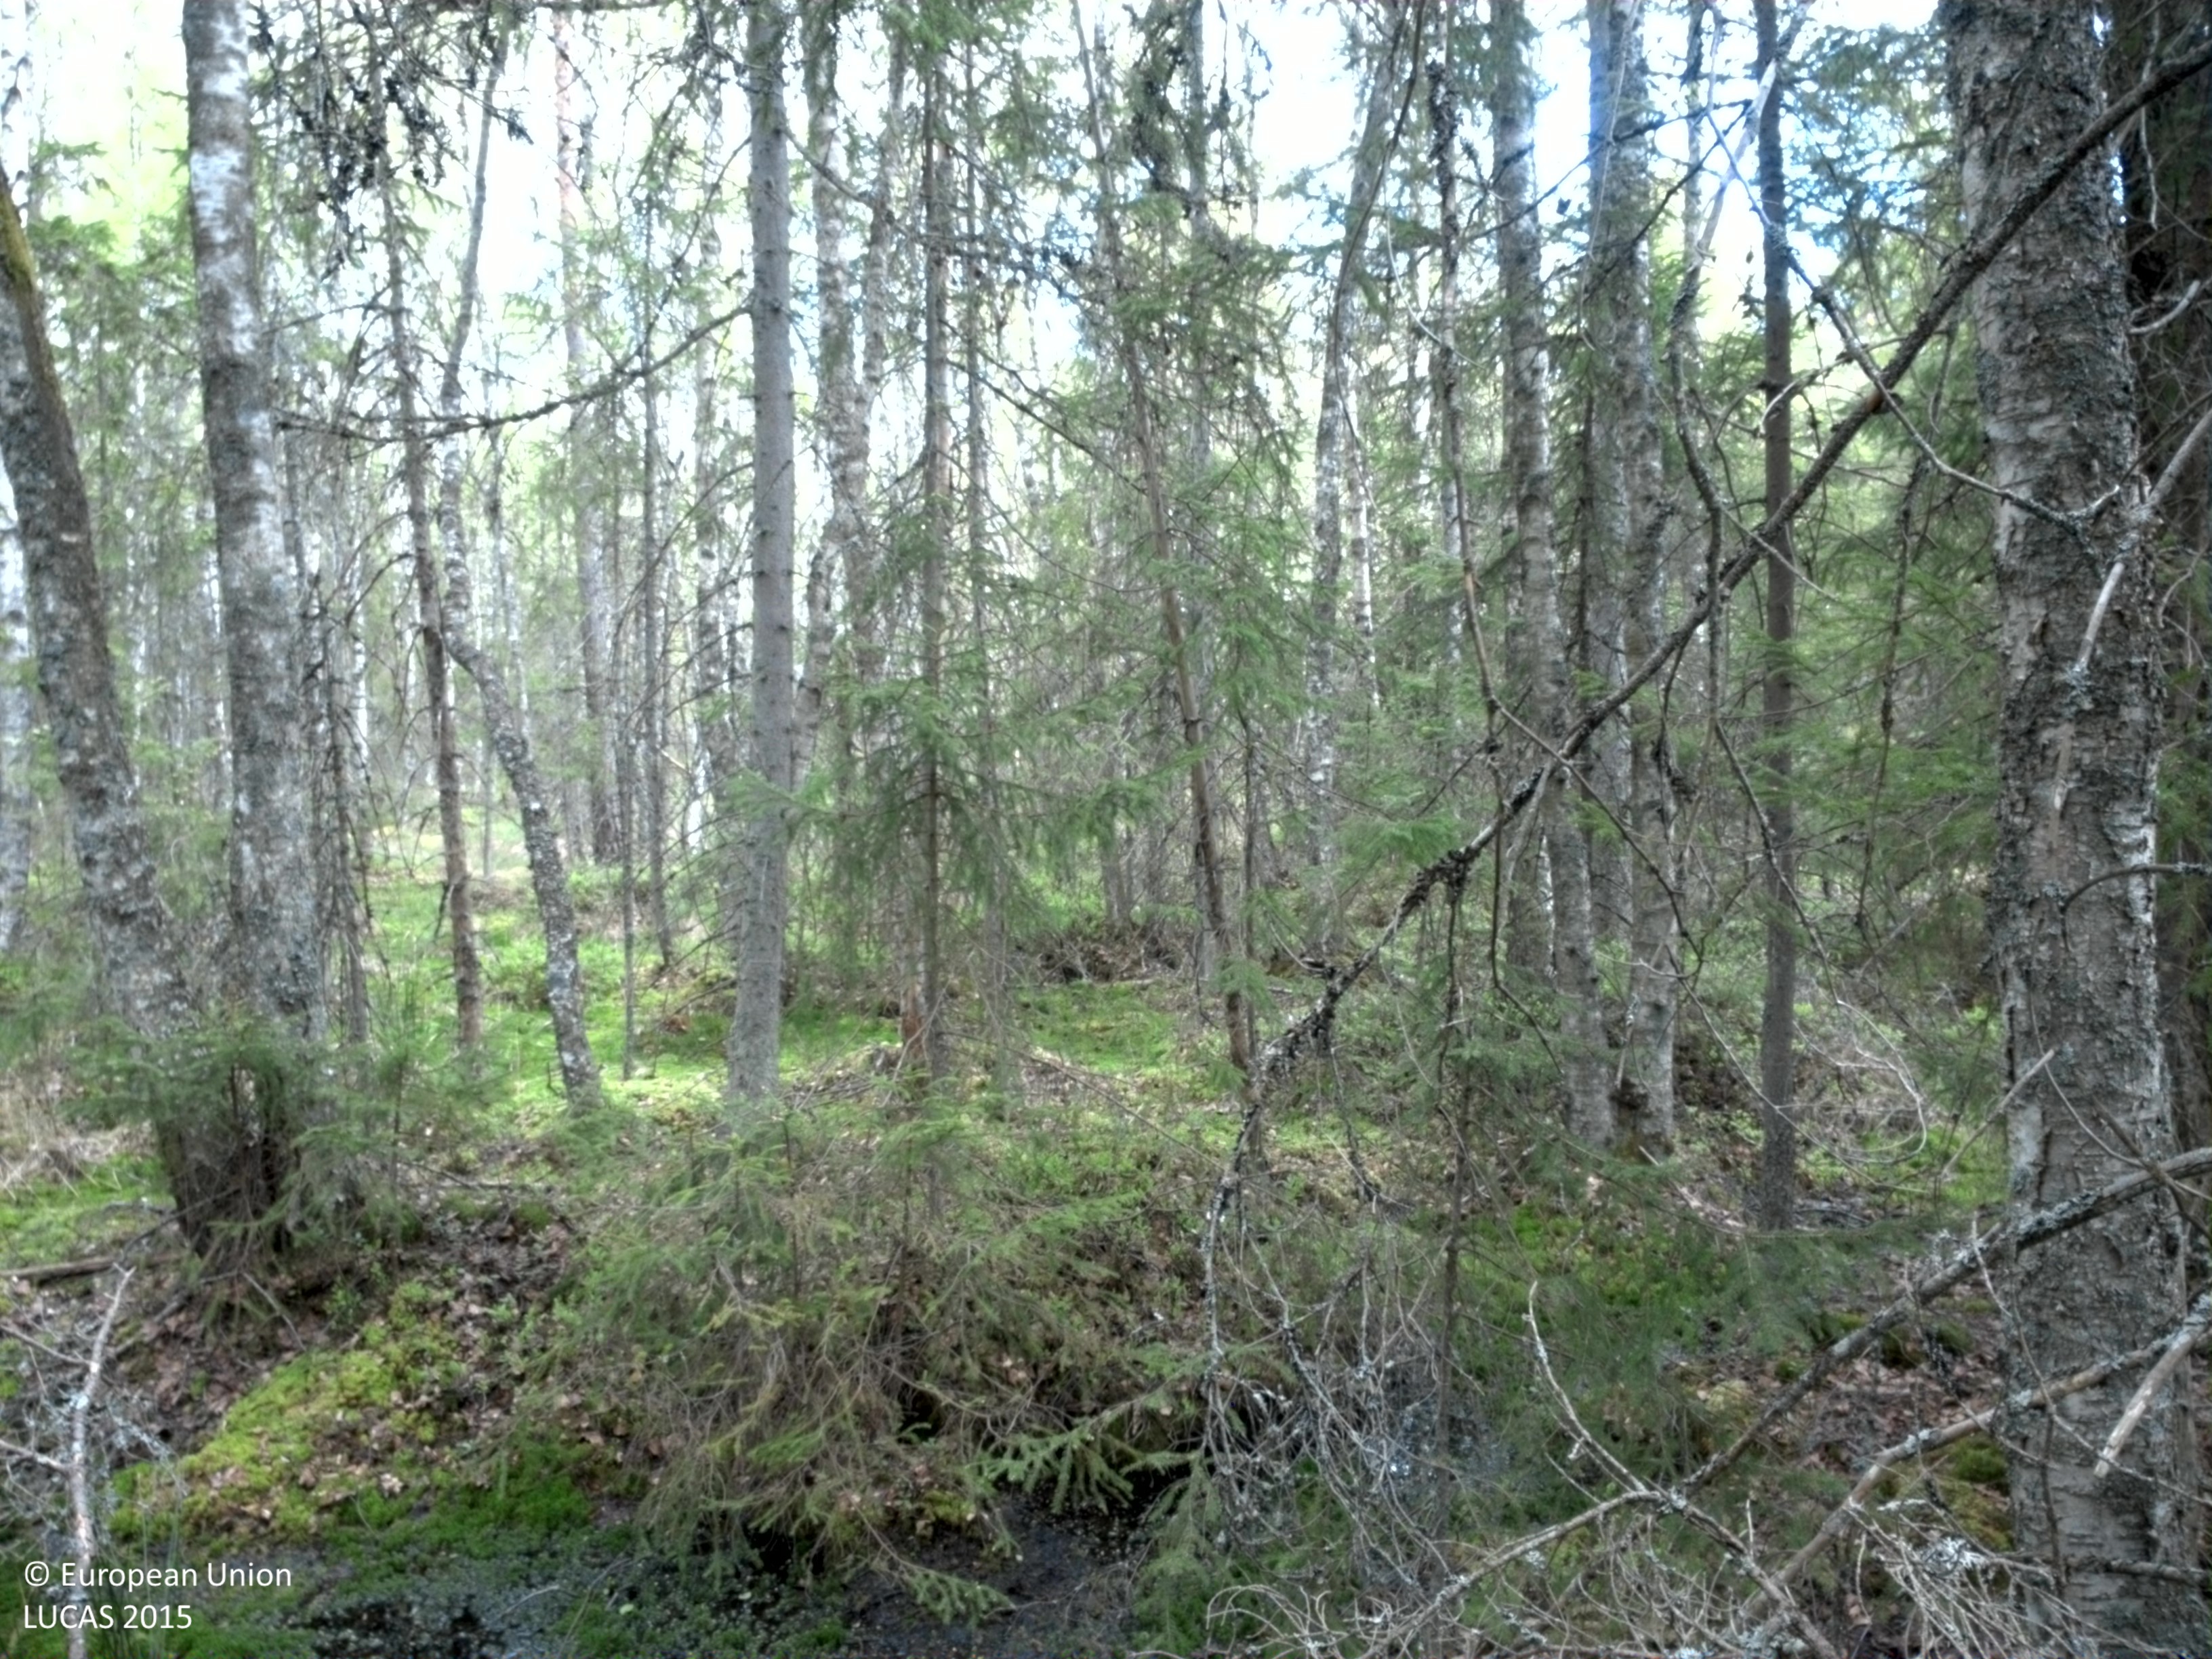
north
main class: Woodland
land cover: Spruce dominated mixed woodland
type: boreal forest
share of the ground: > 75 %
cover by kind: broadleaved forest trees 45 %, coniferous forest trees 35 %, lichens and mosses 20 %
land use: Forestry
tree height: > 5 m
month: May
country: SE
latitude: 56.7153
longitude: 15.1444
